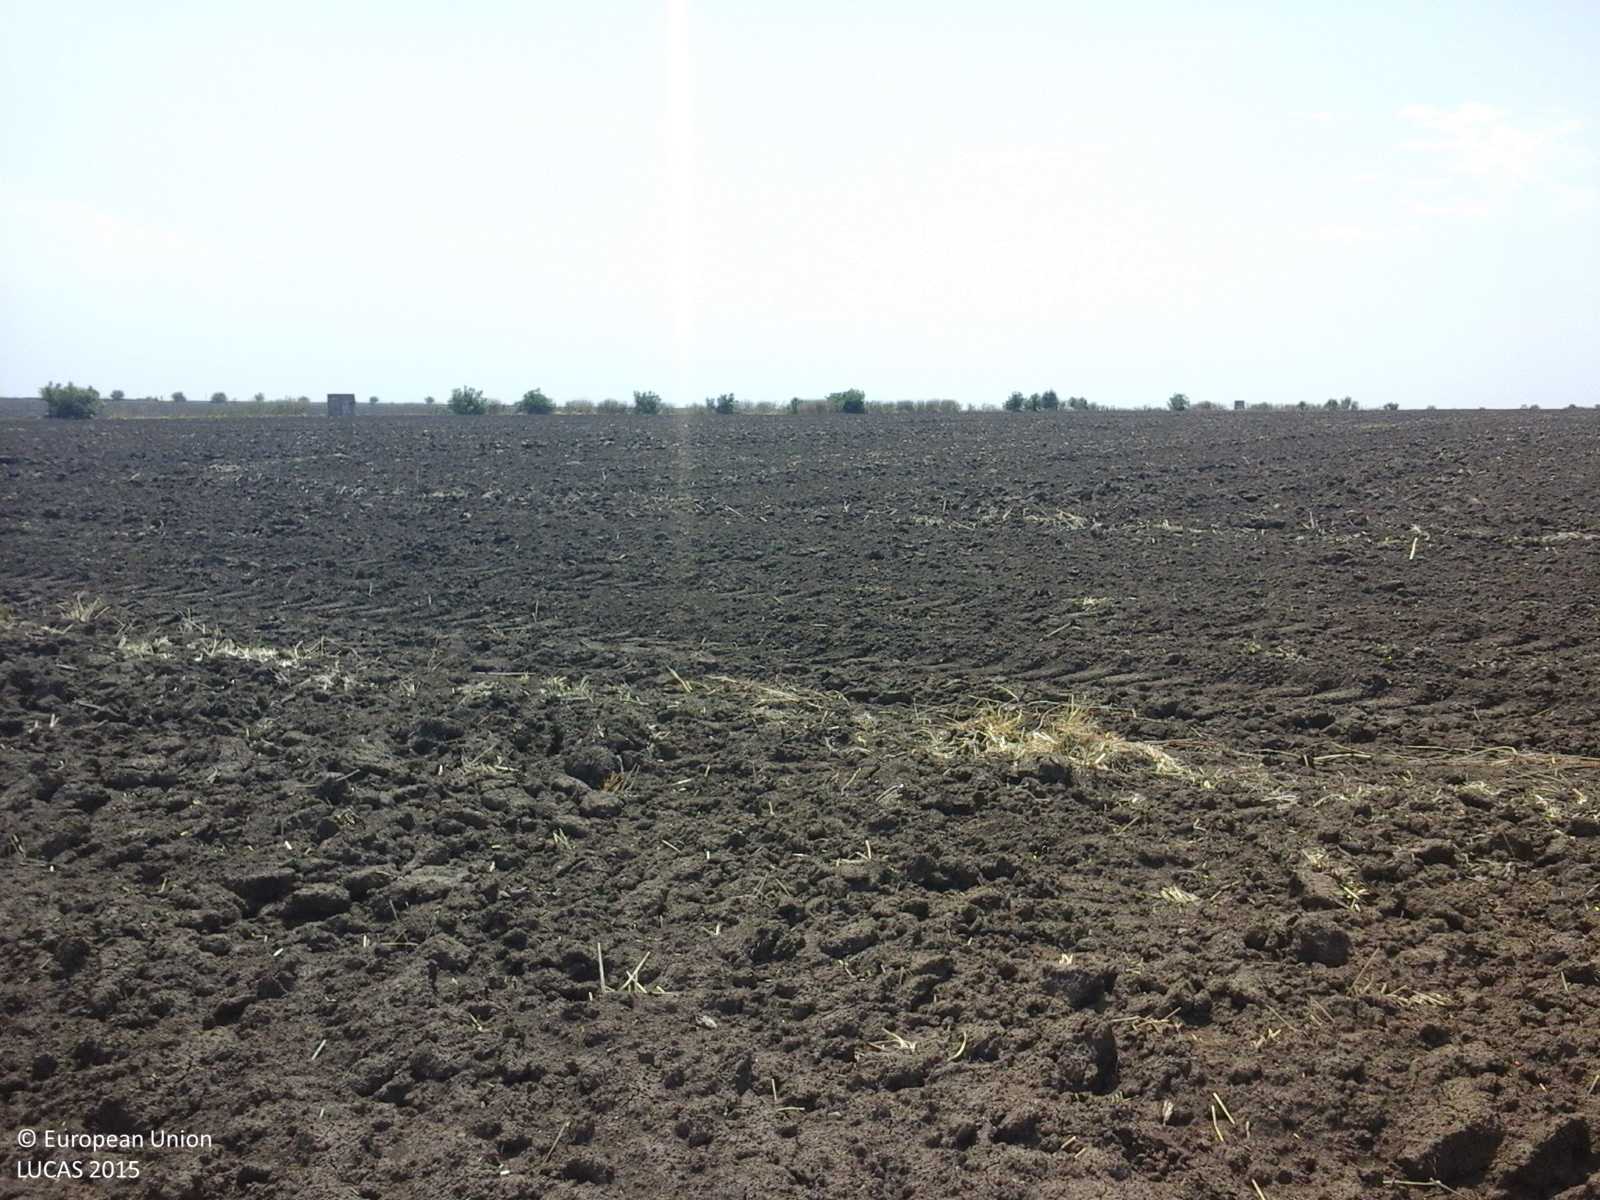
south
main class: Cropland
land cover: Common wheat
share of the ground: < 10 %
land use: Agriculture (excluding fallow land and kitchen gardens)
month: August
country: RO
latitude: 43.9317
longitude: 28.3613
